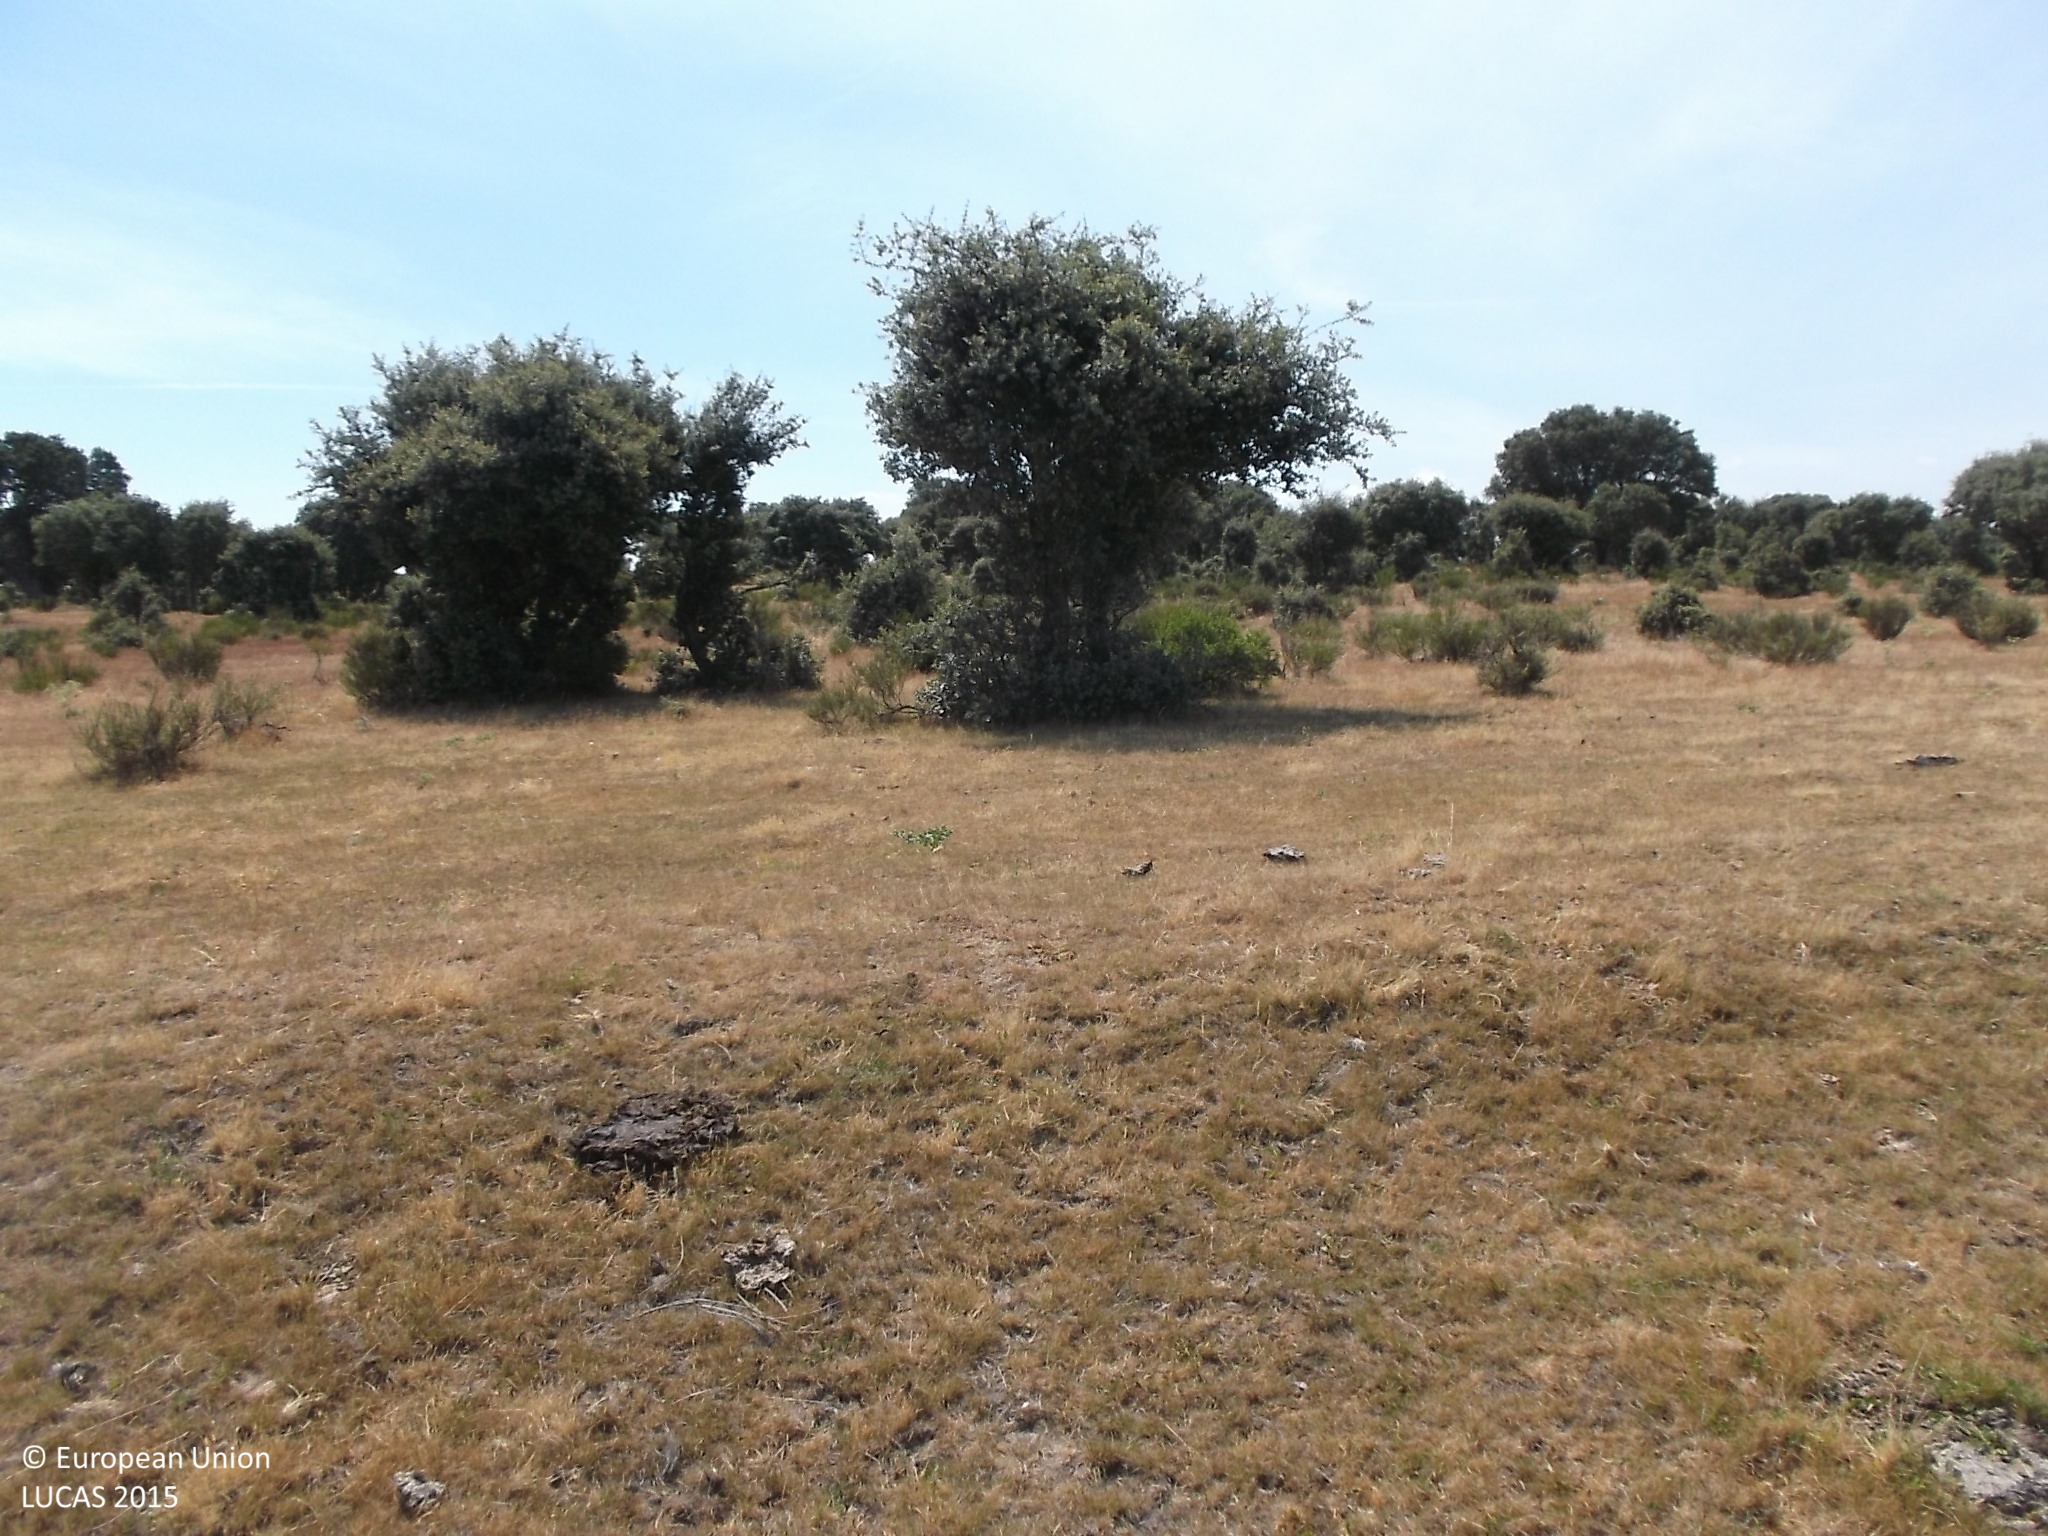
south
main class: Grassland
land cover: Grassland without tree/shrub cover
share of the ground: > 75 %
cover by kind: herbaceous plants 100 %
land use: Agriculture (excluding fallow land and kitchen gardens)
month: June
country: ES
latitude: 41.2309
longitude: -5.9663
